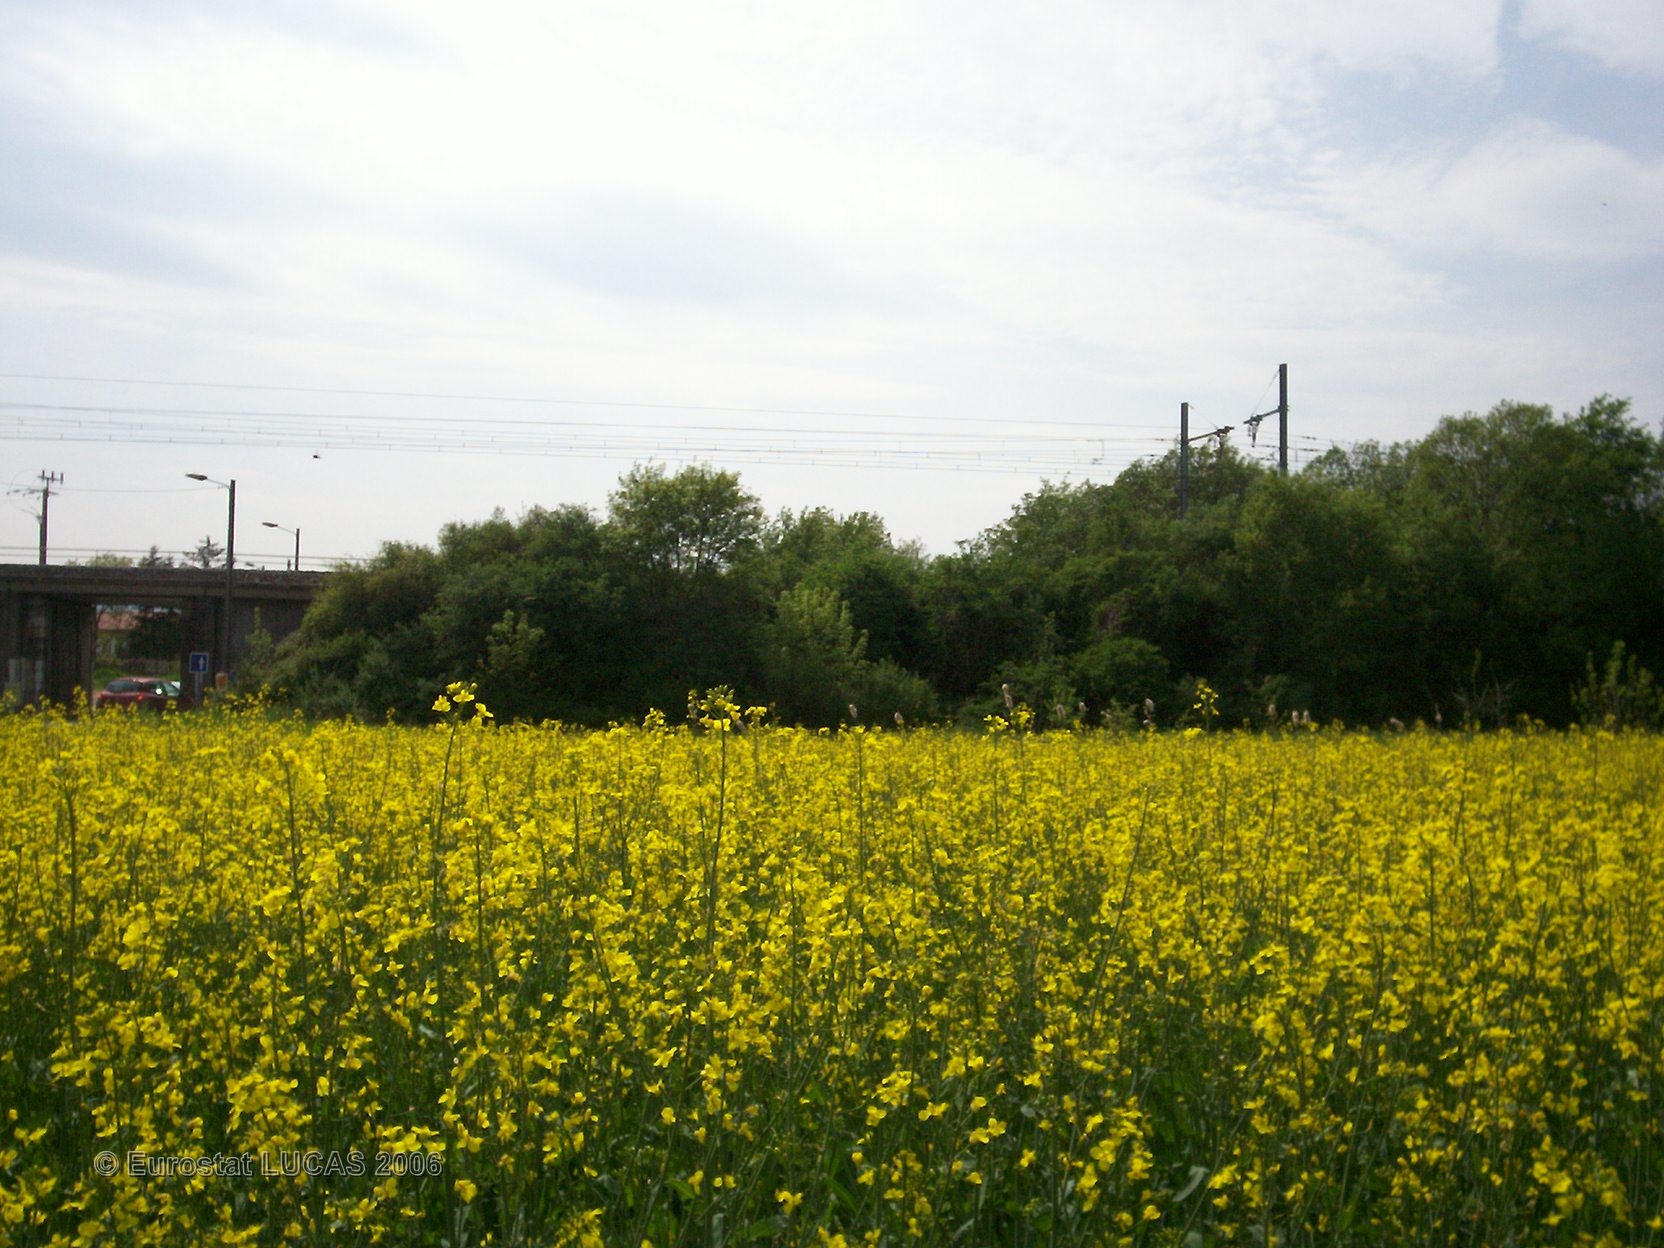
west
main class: Cropland
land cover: Rape and turnip rape
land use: Agriculture (excluding fallow land and kitchen gardens)
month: May
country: FR
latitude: 46.0222
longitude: 4.7195
